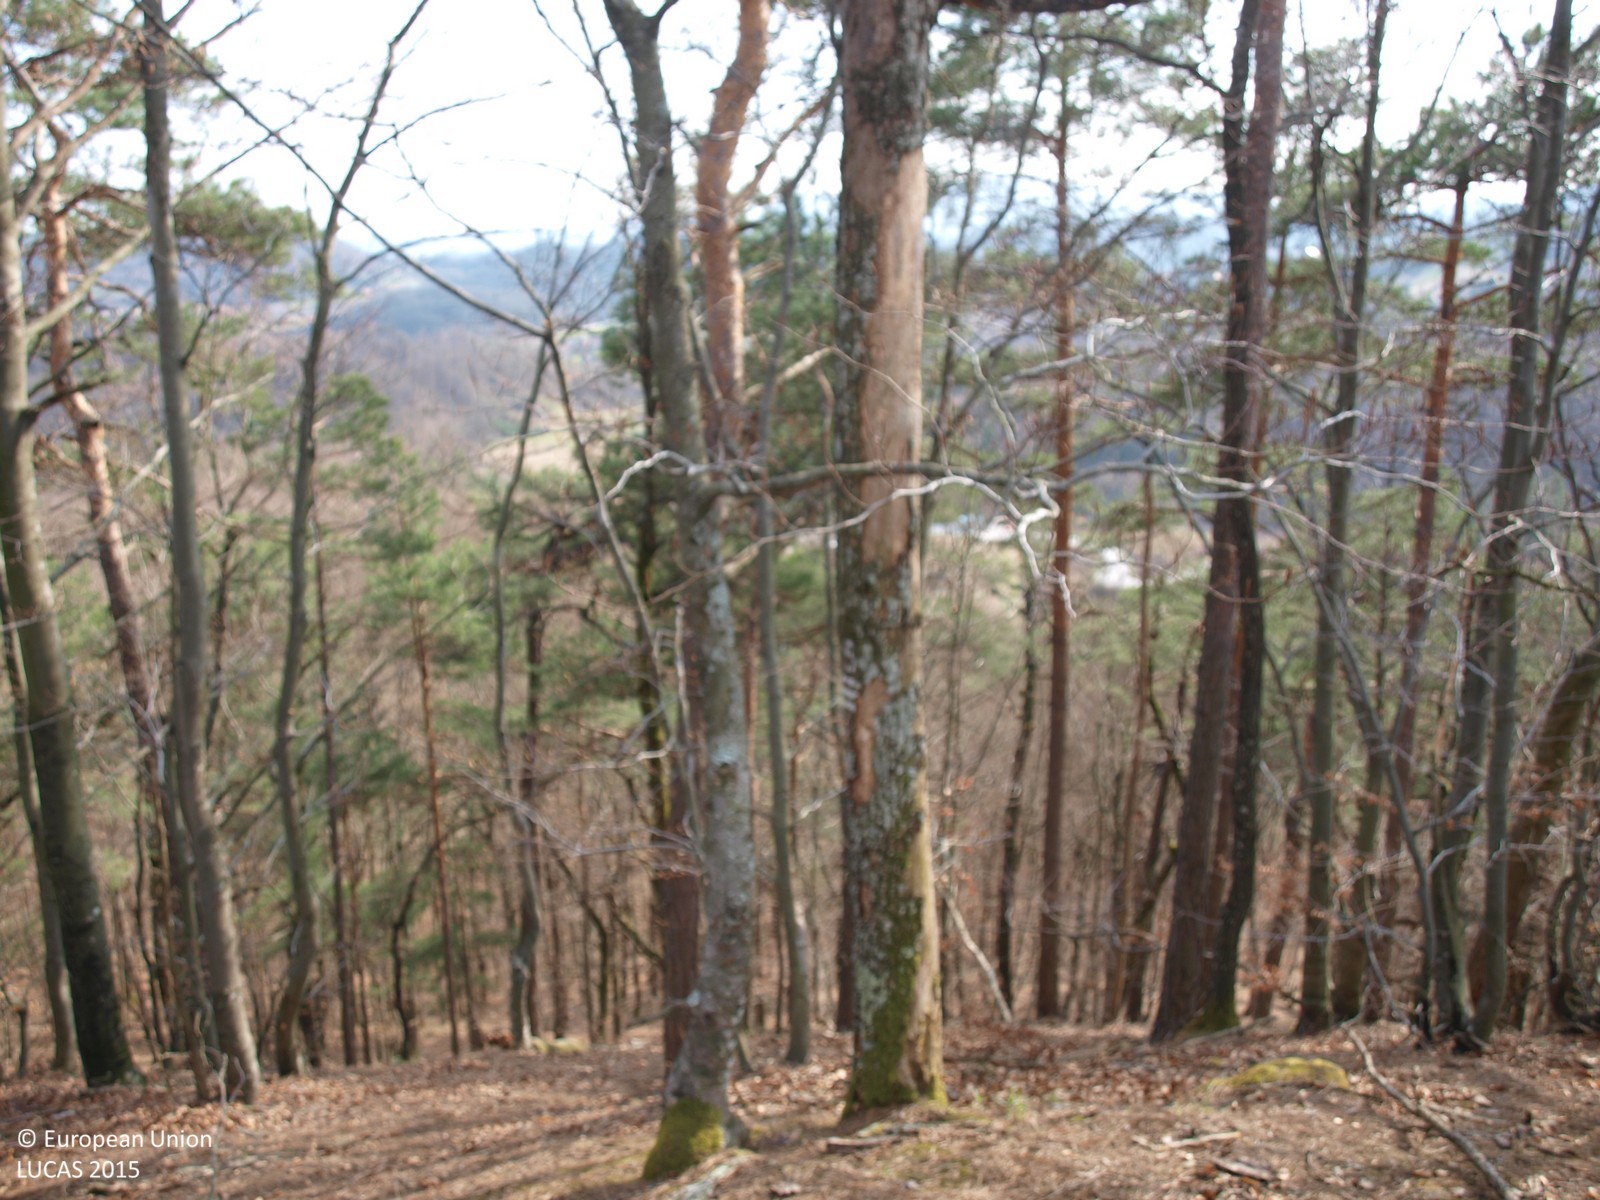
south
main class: Woodland
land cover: Broadleaved woodland
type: mesophytic deciduous forest
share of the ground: > 75 %
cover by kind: broadleaved forest trees 90 %, coniferous forest trees 10 %
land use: Forestry
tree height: > 5 m
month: March
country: HR
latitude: 46.2935
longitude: 15.9575
